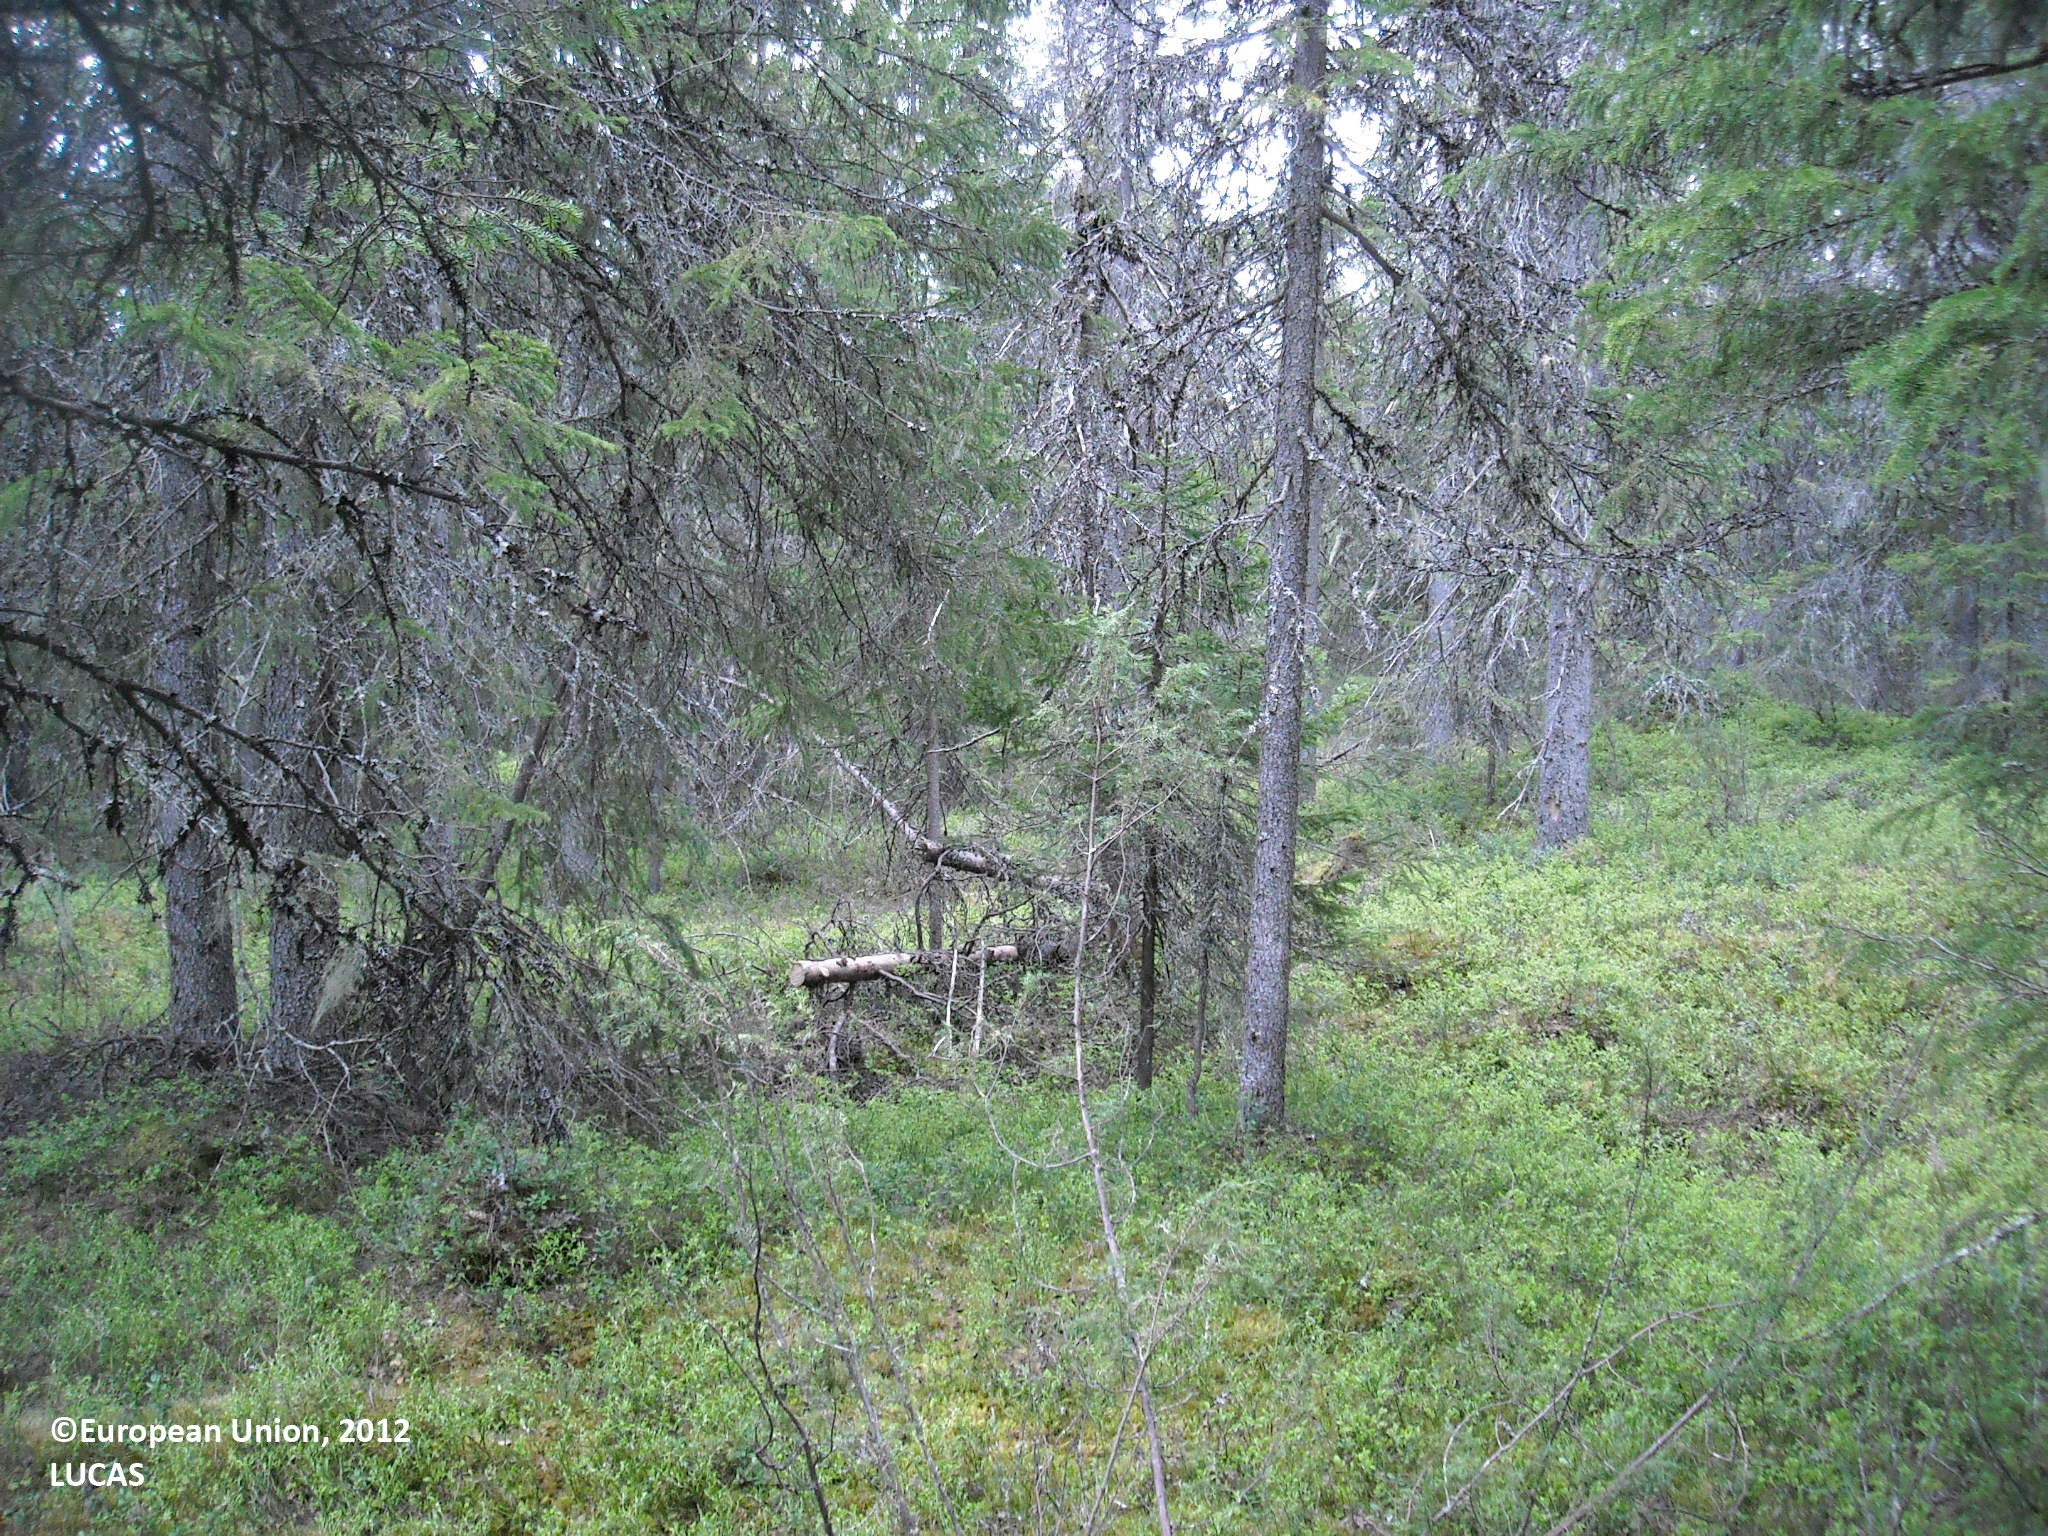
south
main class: Woodland
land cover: Spruce dominated coniferous woodland
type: boreal forest
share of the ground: > 75 %
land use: Forestry
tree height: > 5 m
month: June
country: FI
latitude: 65.3166
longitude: 27.8036
